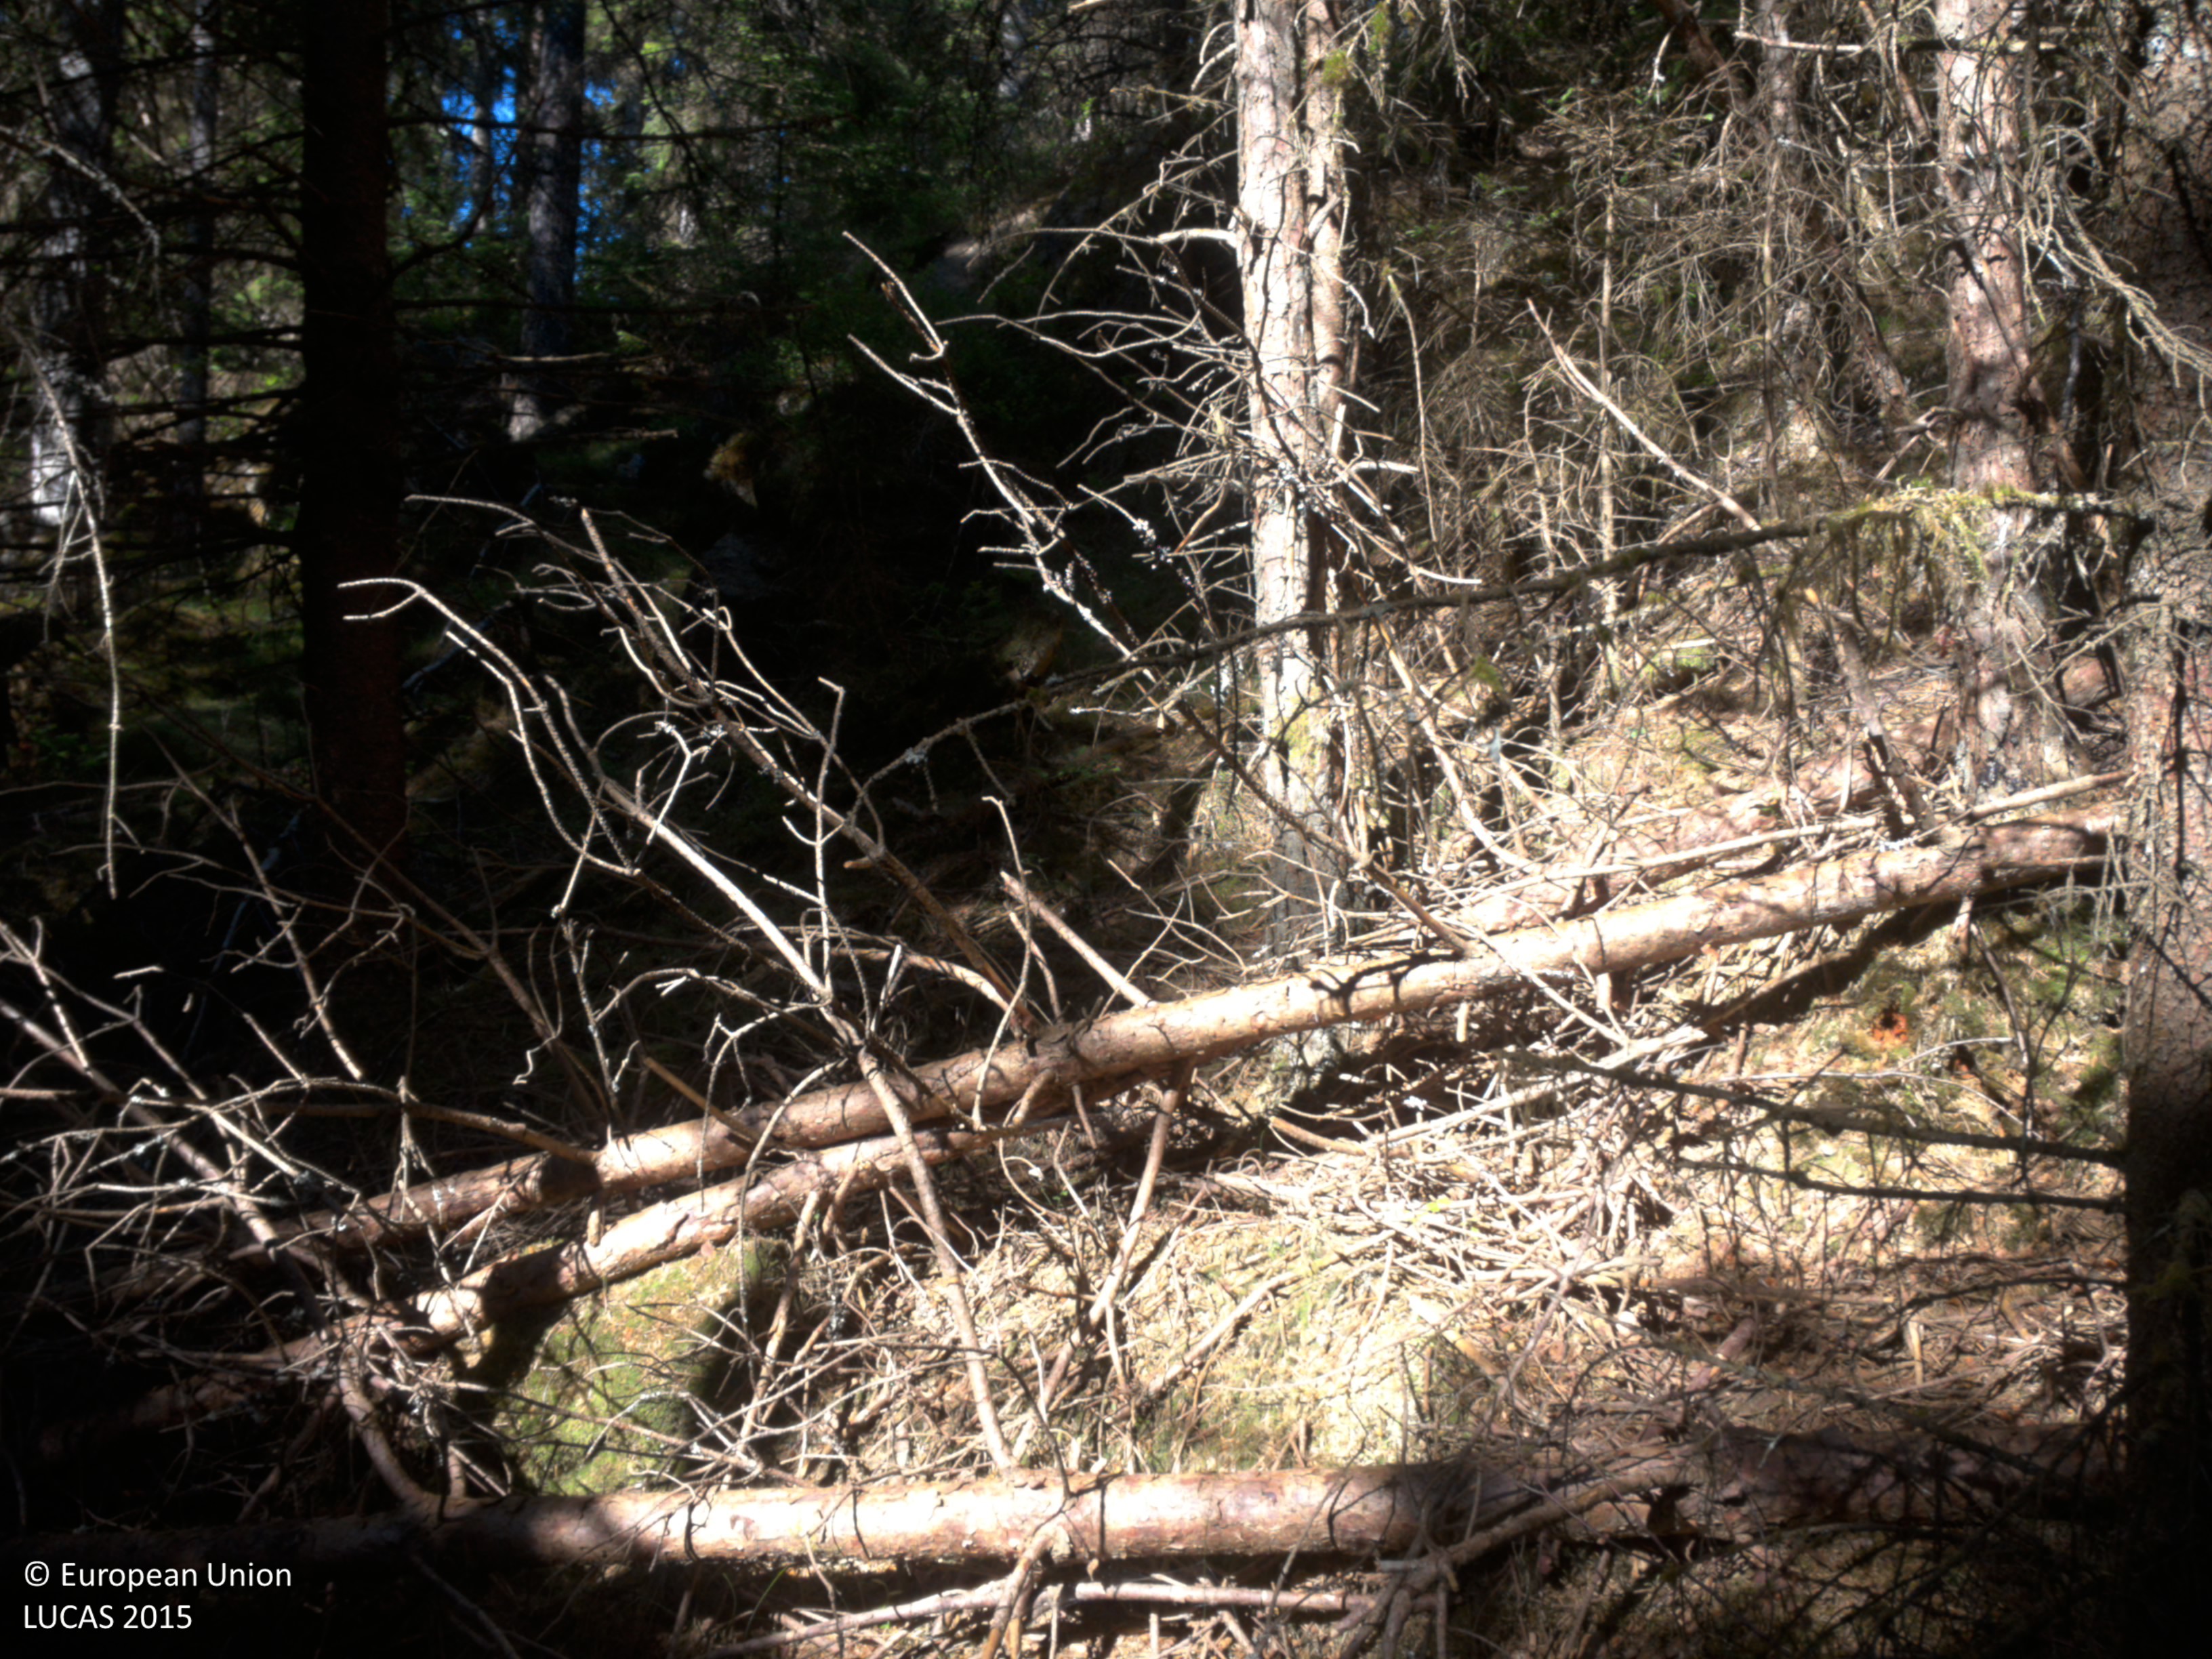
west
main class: Woodland
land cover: Spruce dominated coniferous woodland
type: boreal forest
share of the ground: > 75 %
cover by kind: coniferous forest trees 75 %, lichens and mosses 20 %, broadleaved forest trees 5 %
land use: Forestry
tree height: > 5 m
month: July
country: SE
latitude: 58.4764
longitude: 11.8652
